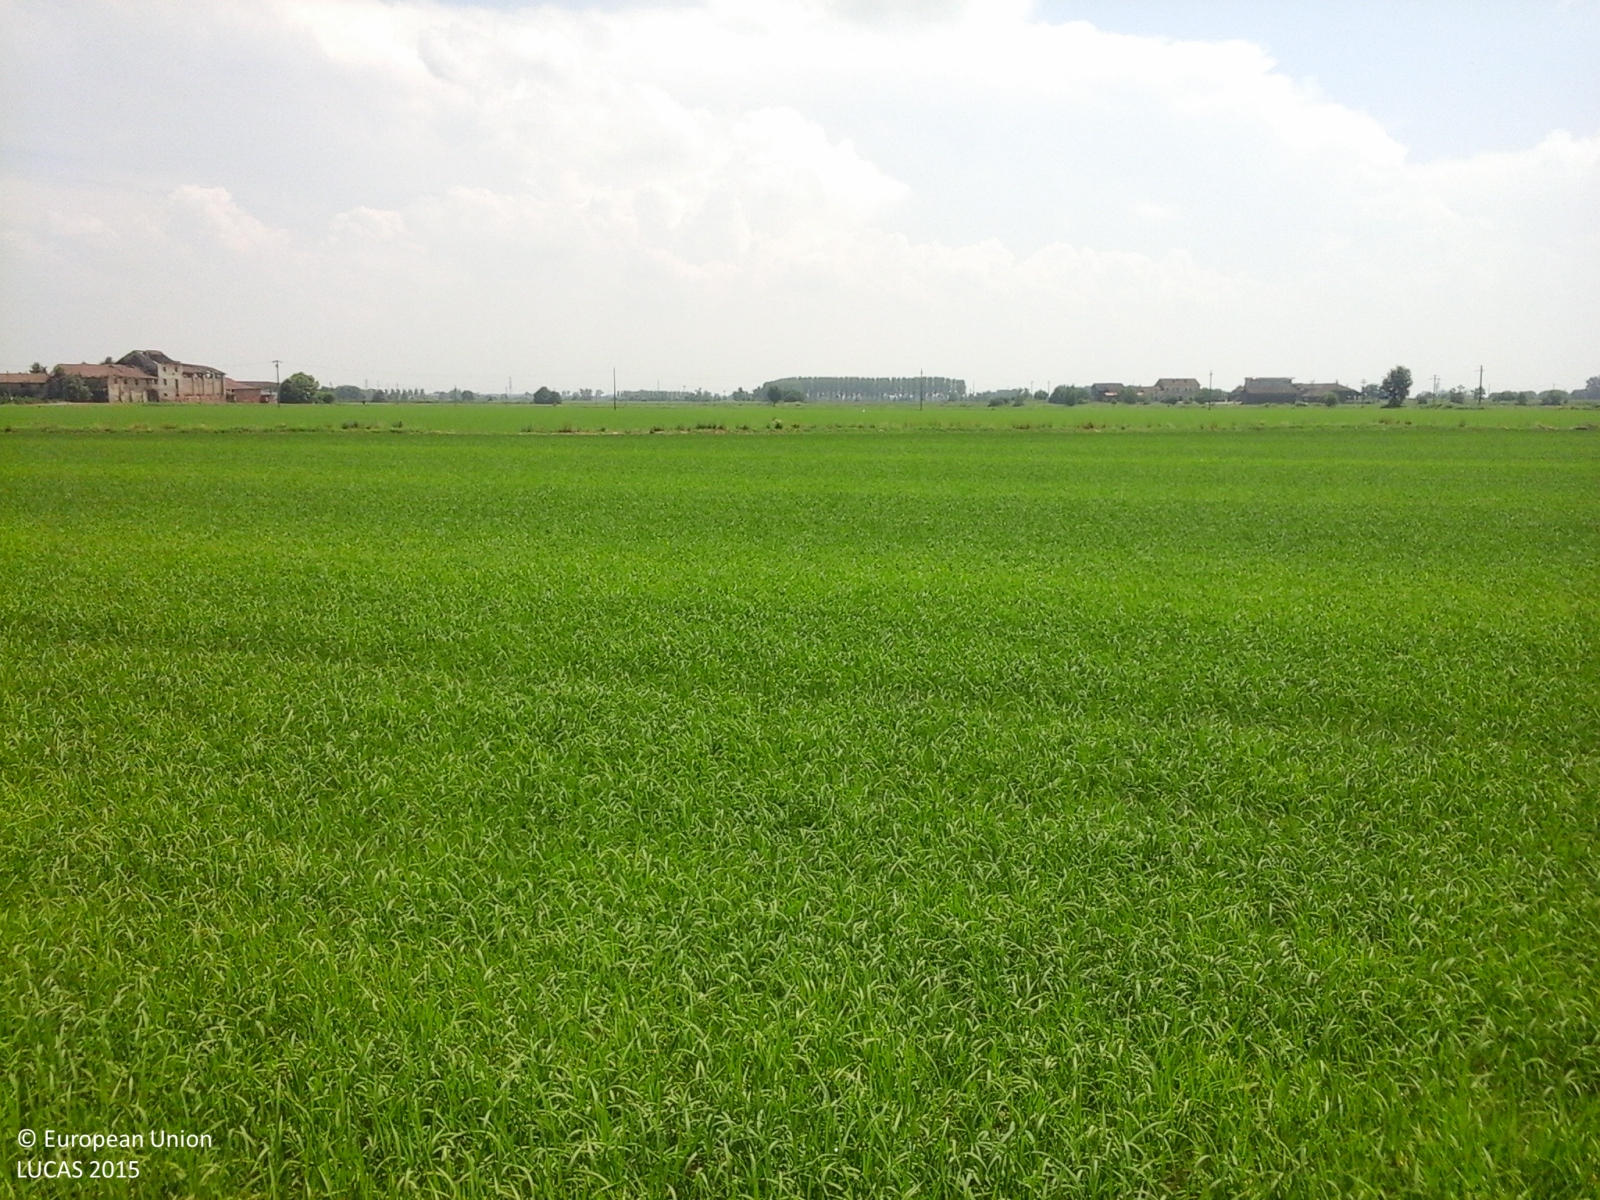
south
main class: Cropland
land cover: Rice
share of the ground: > 75 %
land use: Agriculture (excluding fallow land and kitchen gardens)
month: June
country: IT
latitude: 45.2973
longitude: 8.6379
